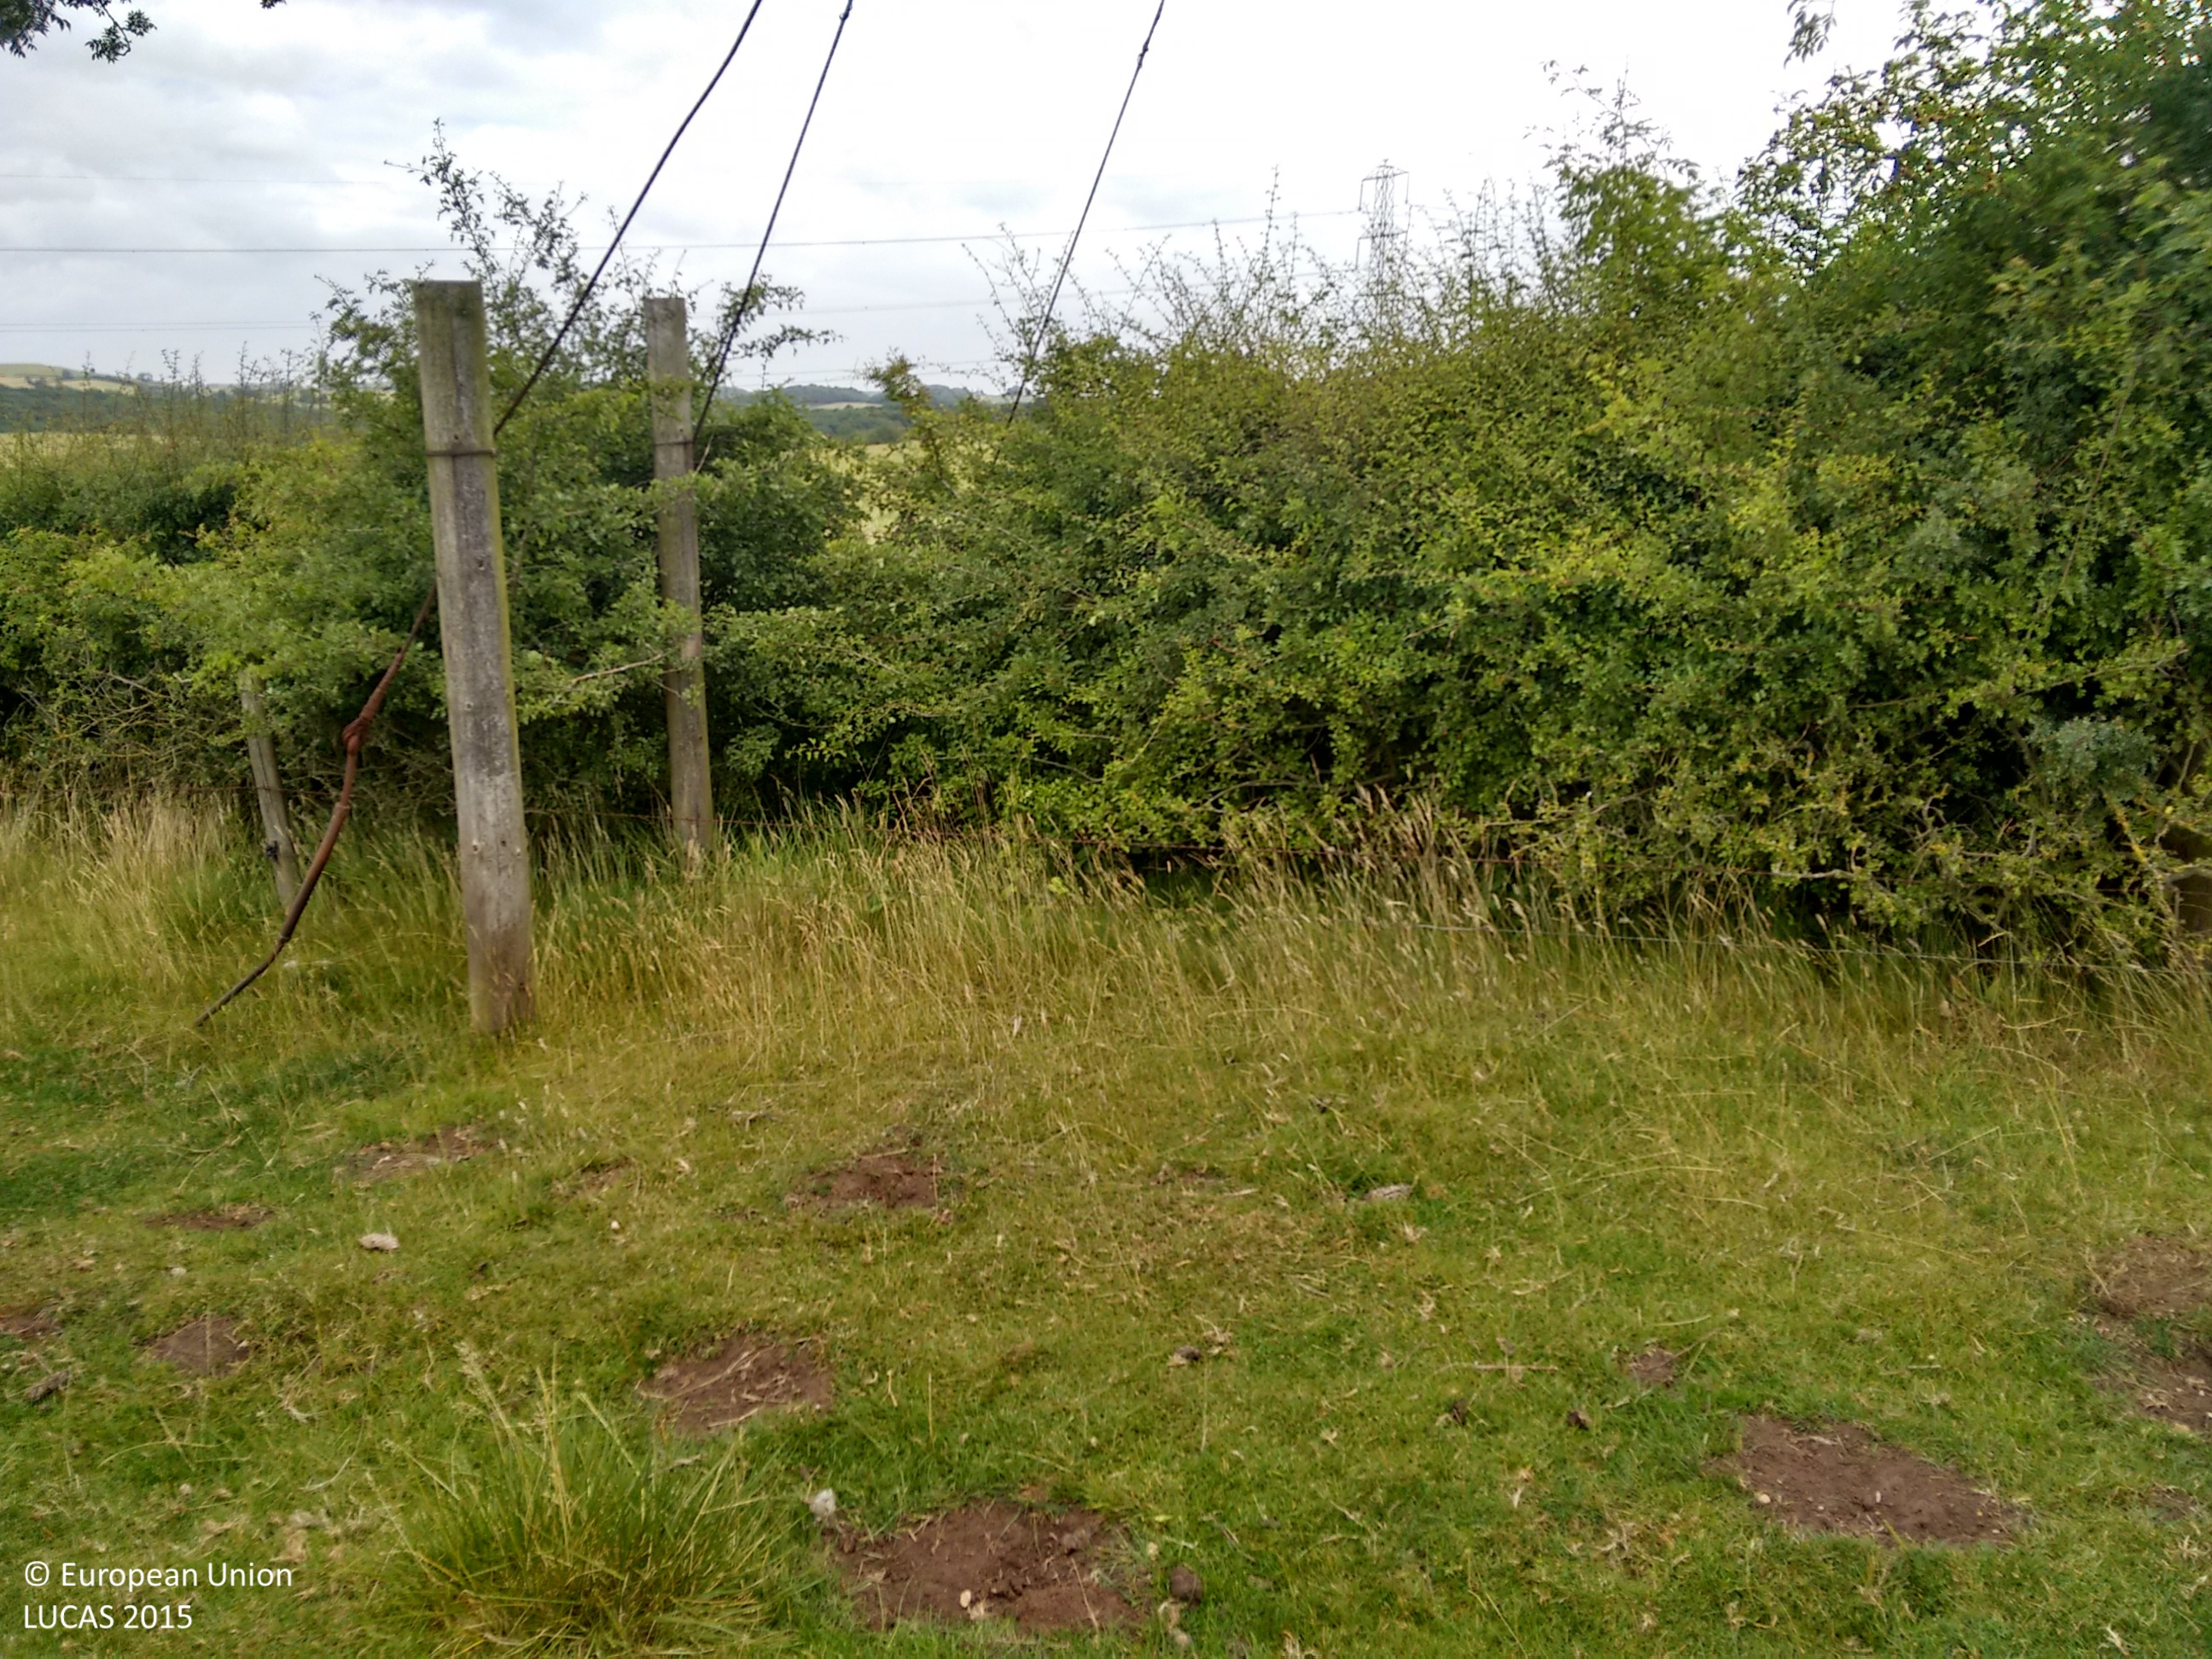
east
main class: Grassland
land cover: Grassland without tree/shrub cover
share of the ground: > 75 %
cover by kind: herbaceous plants 100 %
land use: Agriculture (excluding fallow land and kitchen gardens)
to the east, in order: Grassland without tree/shrub cover; Electric lines; Fences; Managed hedges; Ditches and canals; Grass margins; Rape and turnip rape; Electric lines; Rape and turnip rape
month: July
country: GB
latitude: 52.6180
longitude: -0.8991
